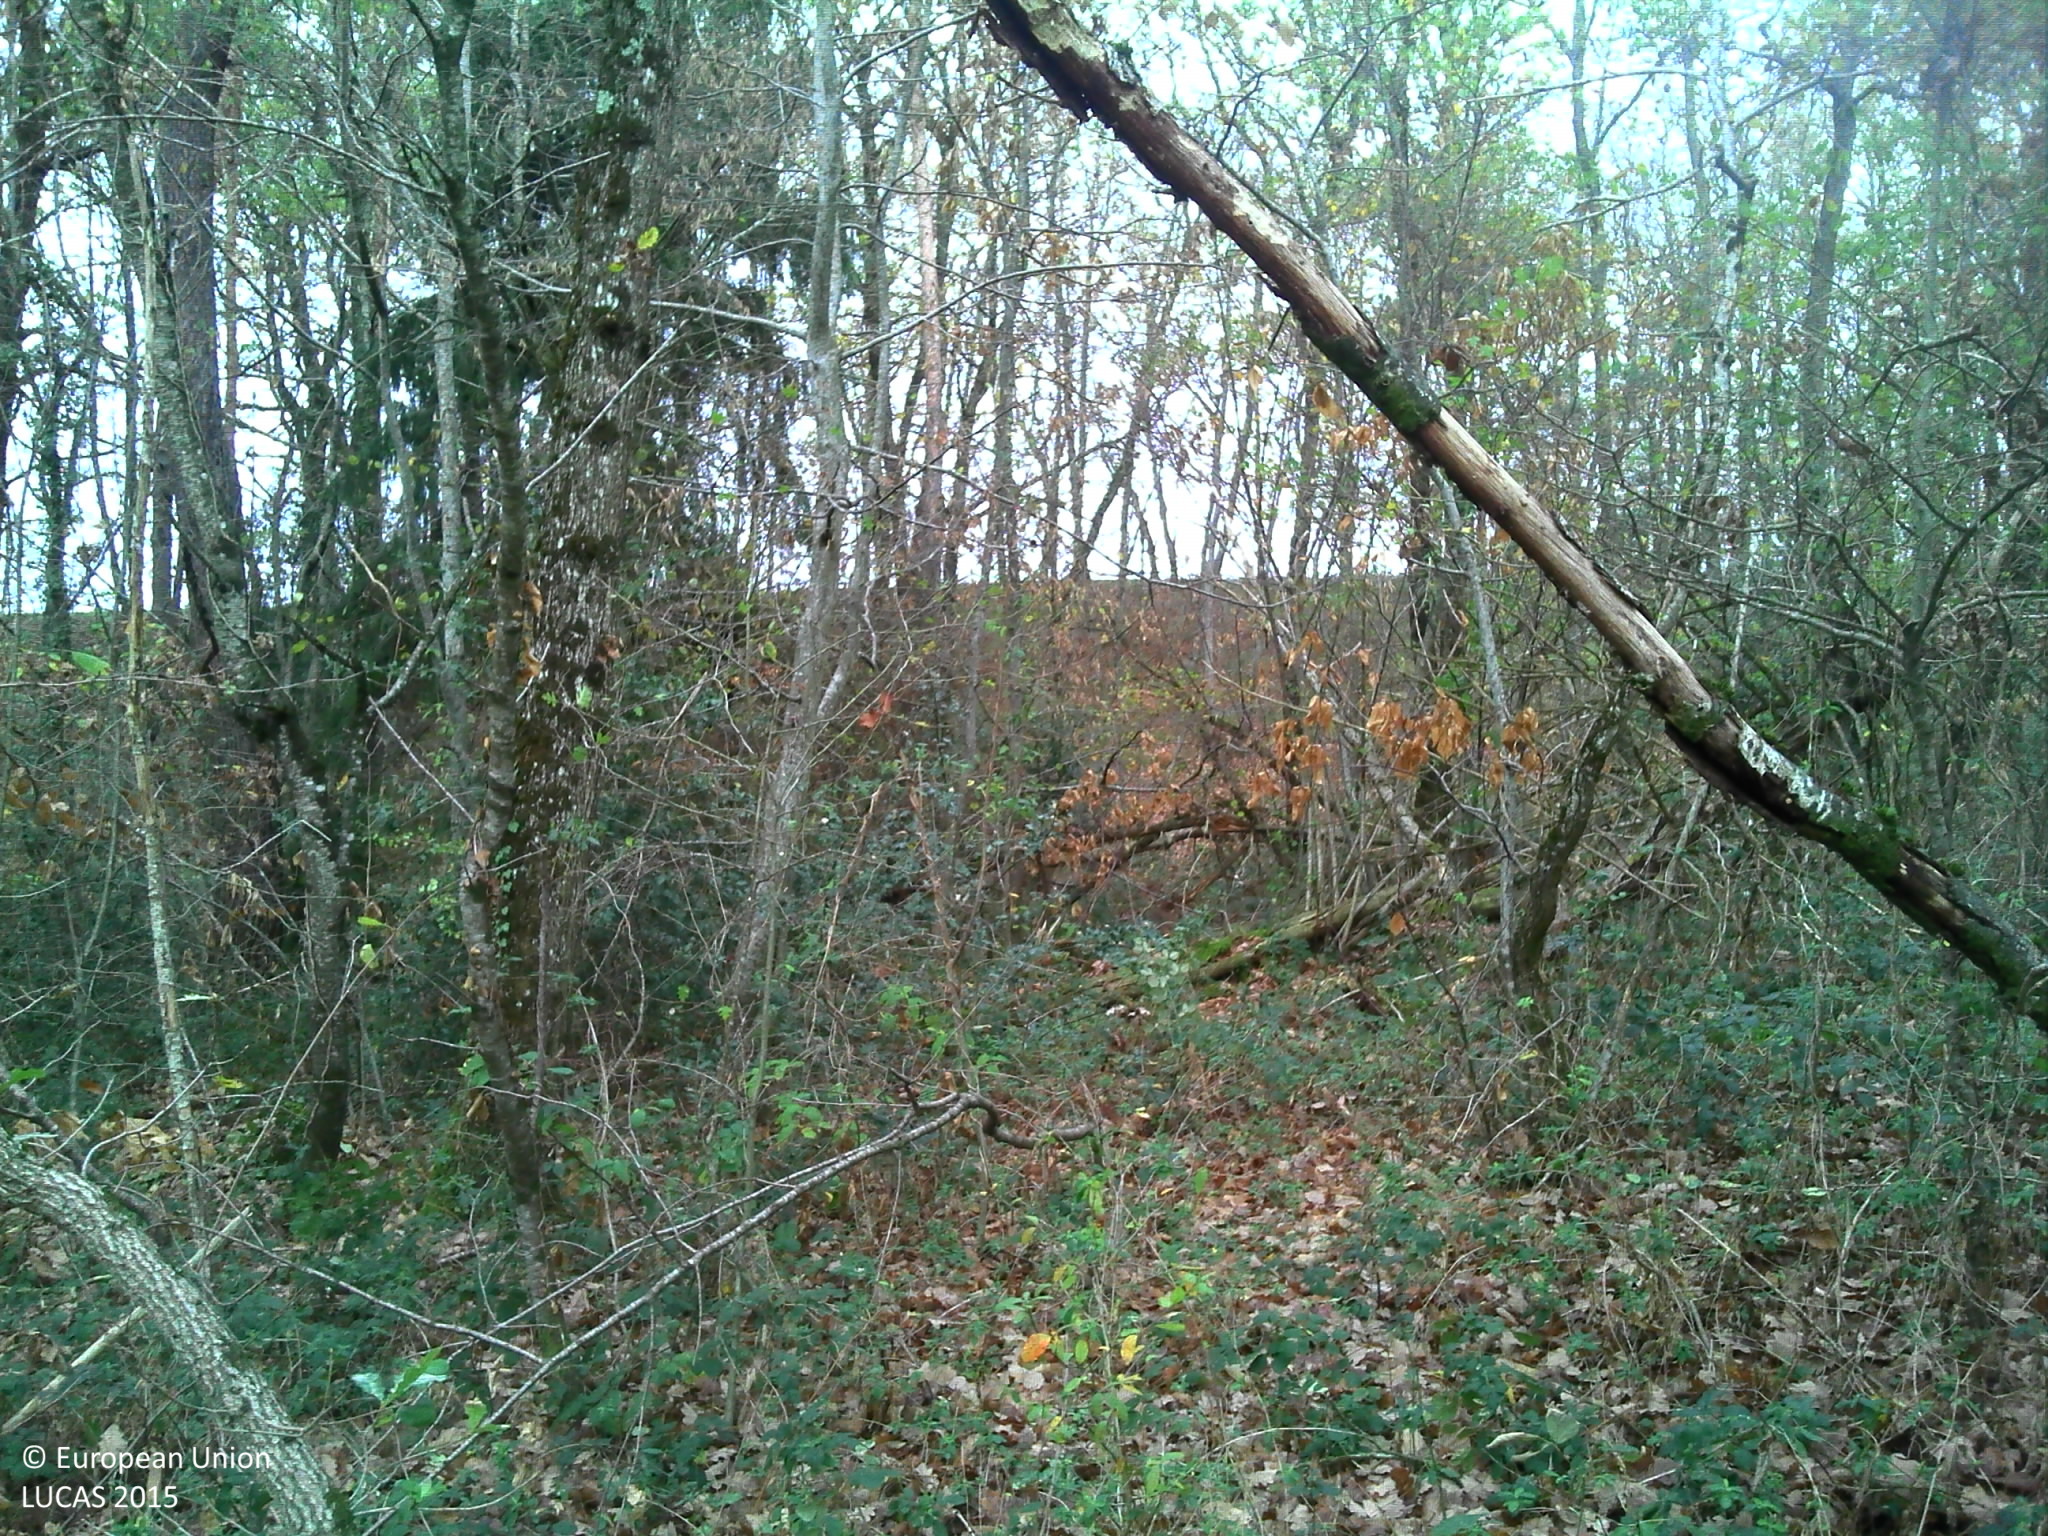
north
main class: Woodland
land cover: Broadleaved woodland
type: acidophilous oak and oak-birch forest
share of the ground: 50 - 75 %
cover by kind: broadleaved forest trees 70 %, shrubs 10 %, herbaceous plants 10 %, consolidated bare surface 10 %
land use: Forestry
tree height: > 5 m
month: November
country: FR
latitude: 46.2906
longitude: 3.6784
